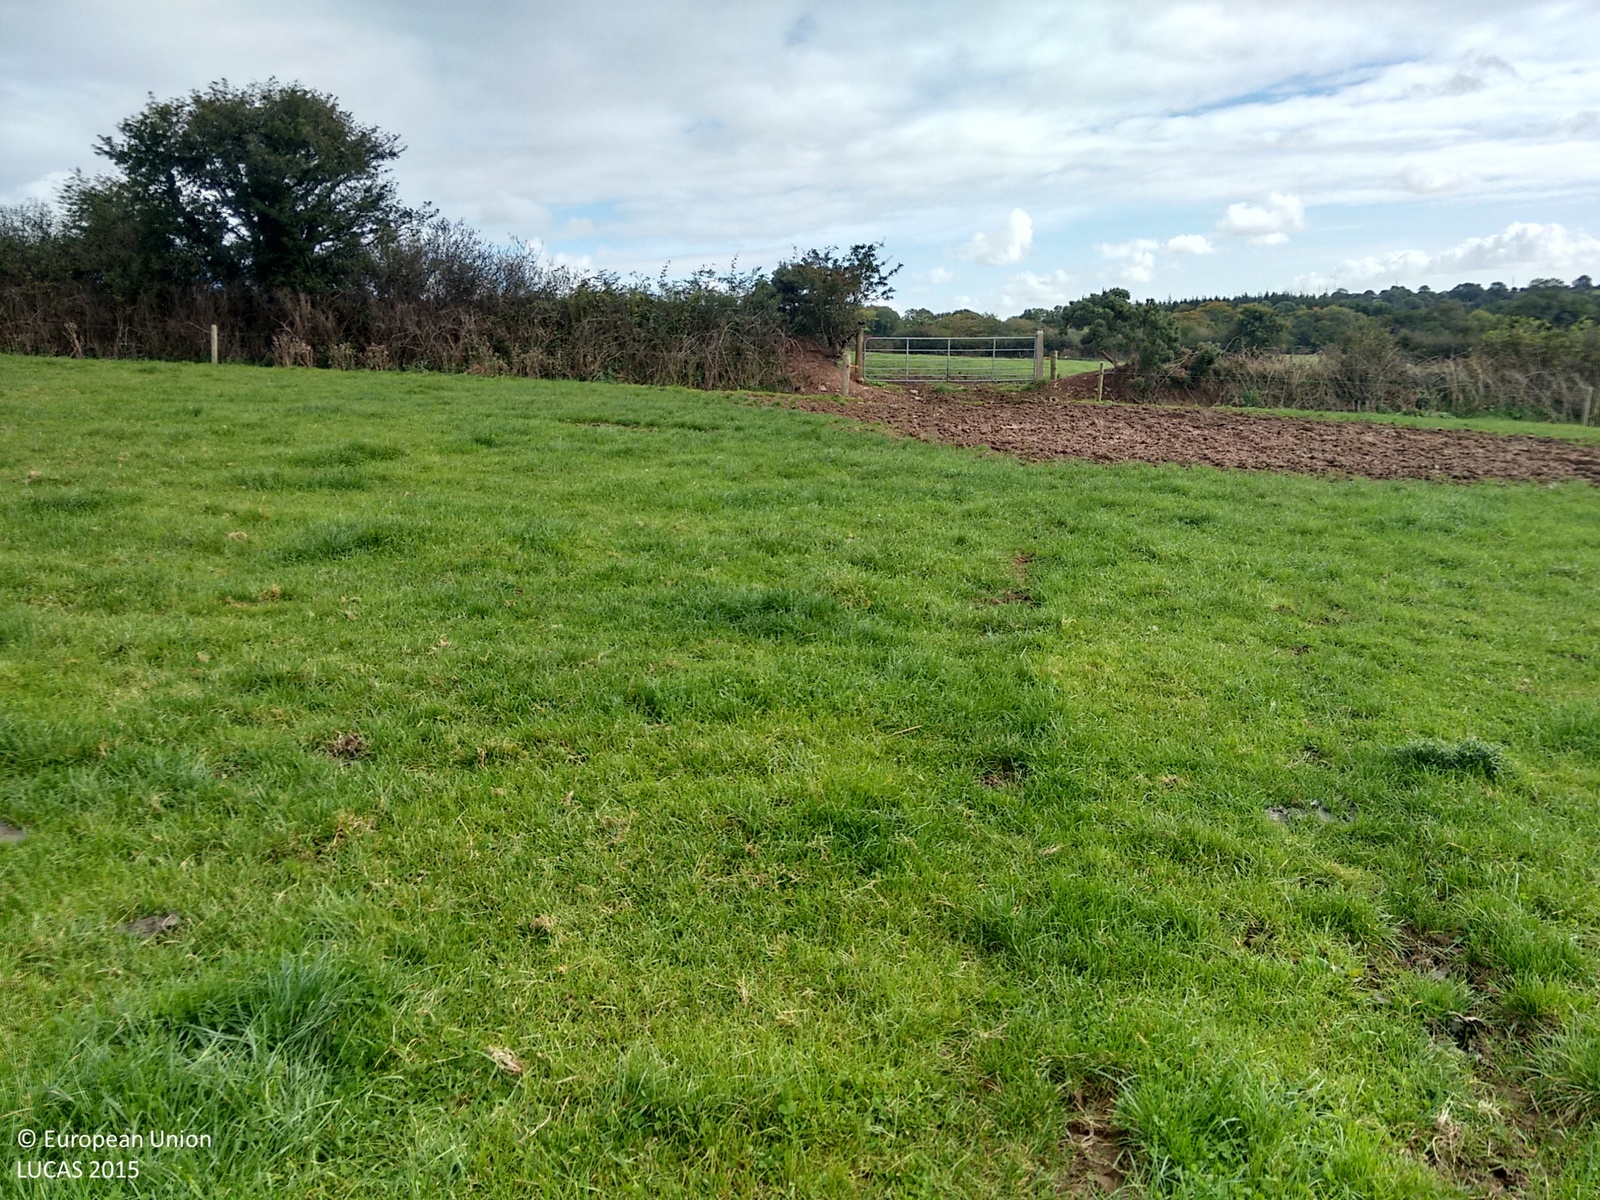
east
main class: Grassland
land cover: Grassland without tree/shrub cover
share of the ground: > 75 %
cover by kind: herbaceous plants 100 %
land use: Agriculture (excluding fallow land and kitchen gardens)
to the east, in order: Grassland without tree/shrub cover; Fences; Abandoned hedges; Fences; Grassland without tree/shrub cover; Fences; Abandoned hedges; Ditches and canals; Fences; Grassland without tree/shrub cover; Other bare soil; Grassland without tree/shrub cover
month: October
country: IE
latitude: 51.9602
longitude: -8.3657
